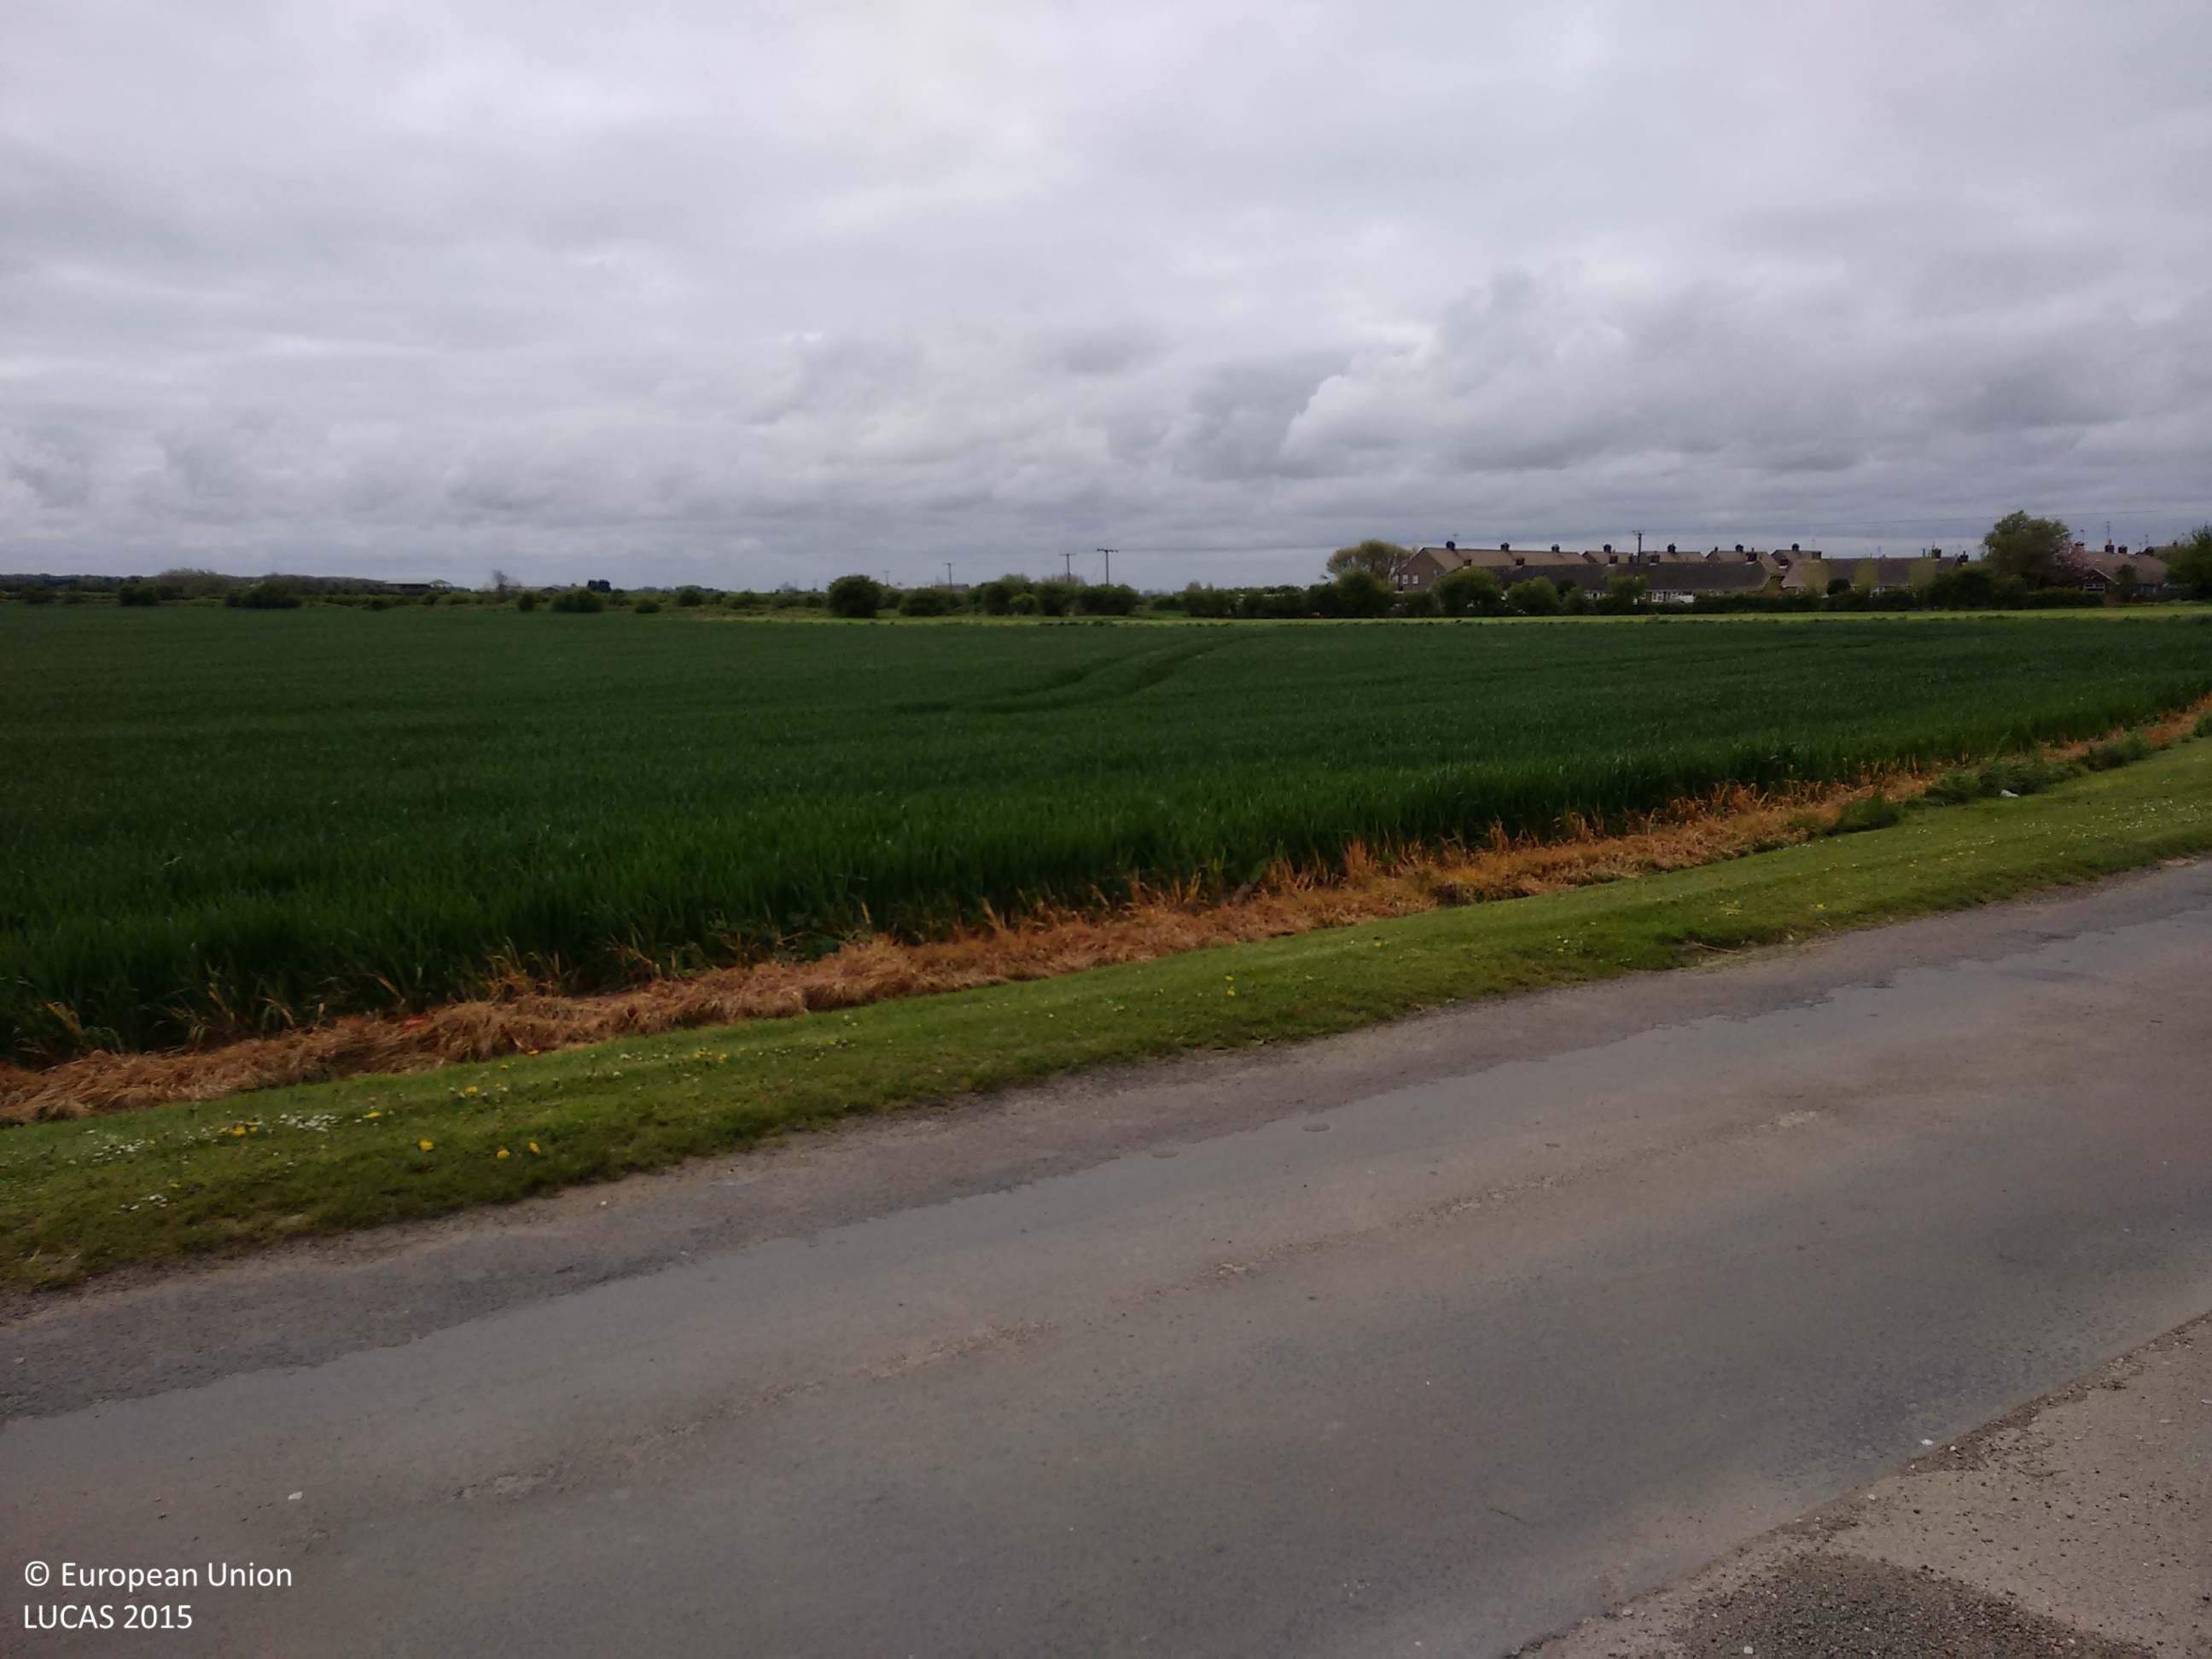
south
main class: Grassland
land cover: Grassland without tree/shrub cover
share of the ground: > 75 %
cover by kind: herbaceous plants 100 %
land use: Residential
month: May
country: GB
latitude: 53.8299
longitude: -0.1058
